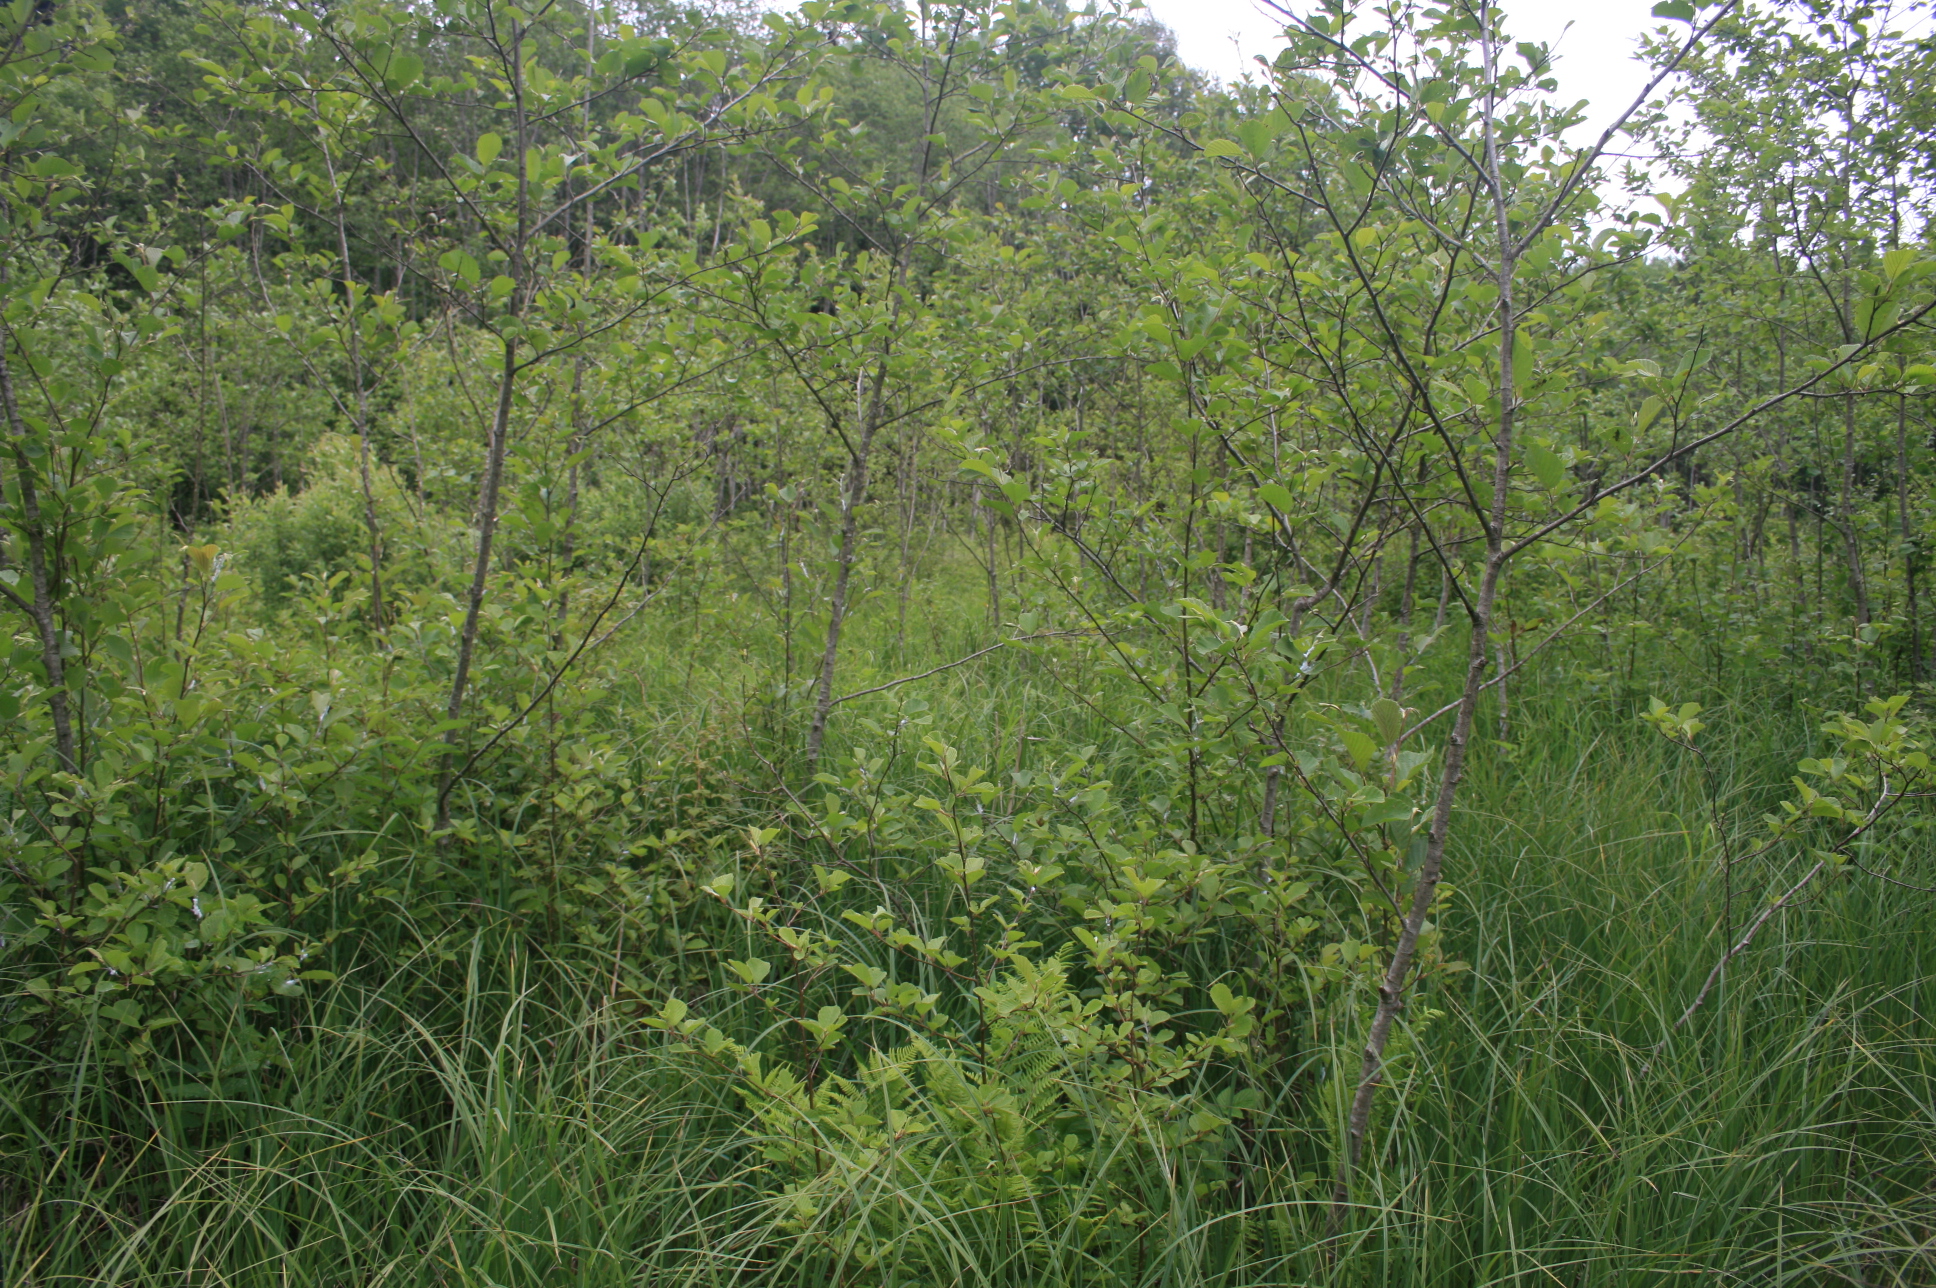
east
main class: Woodland
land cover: Broadleaved woodland
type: non-riverine alder, birch or aspen forest
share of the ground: 50 - 75 %
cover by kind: broadleaved forest trees 60 %, herbaceous plants 40 %
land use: Forestry
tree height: < 5 m
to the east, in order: Broadleaved woodland; Spruce dominated coniferous woodland; Spruce dominated mixed woodland; Broadleaved woodland
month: June
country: LT
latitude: 55.5495
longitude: 22.3747
